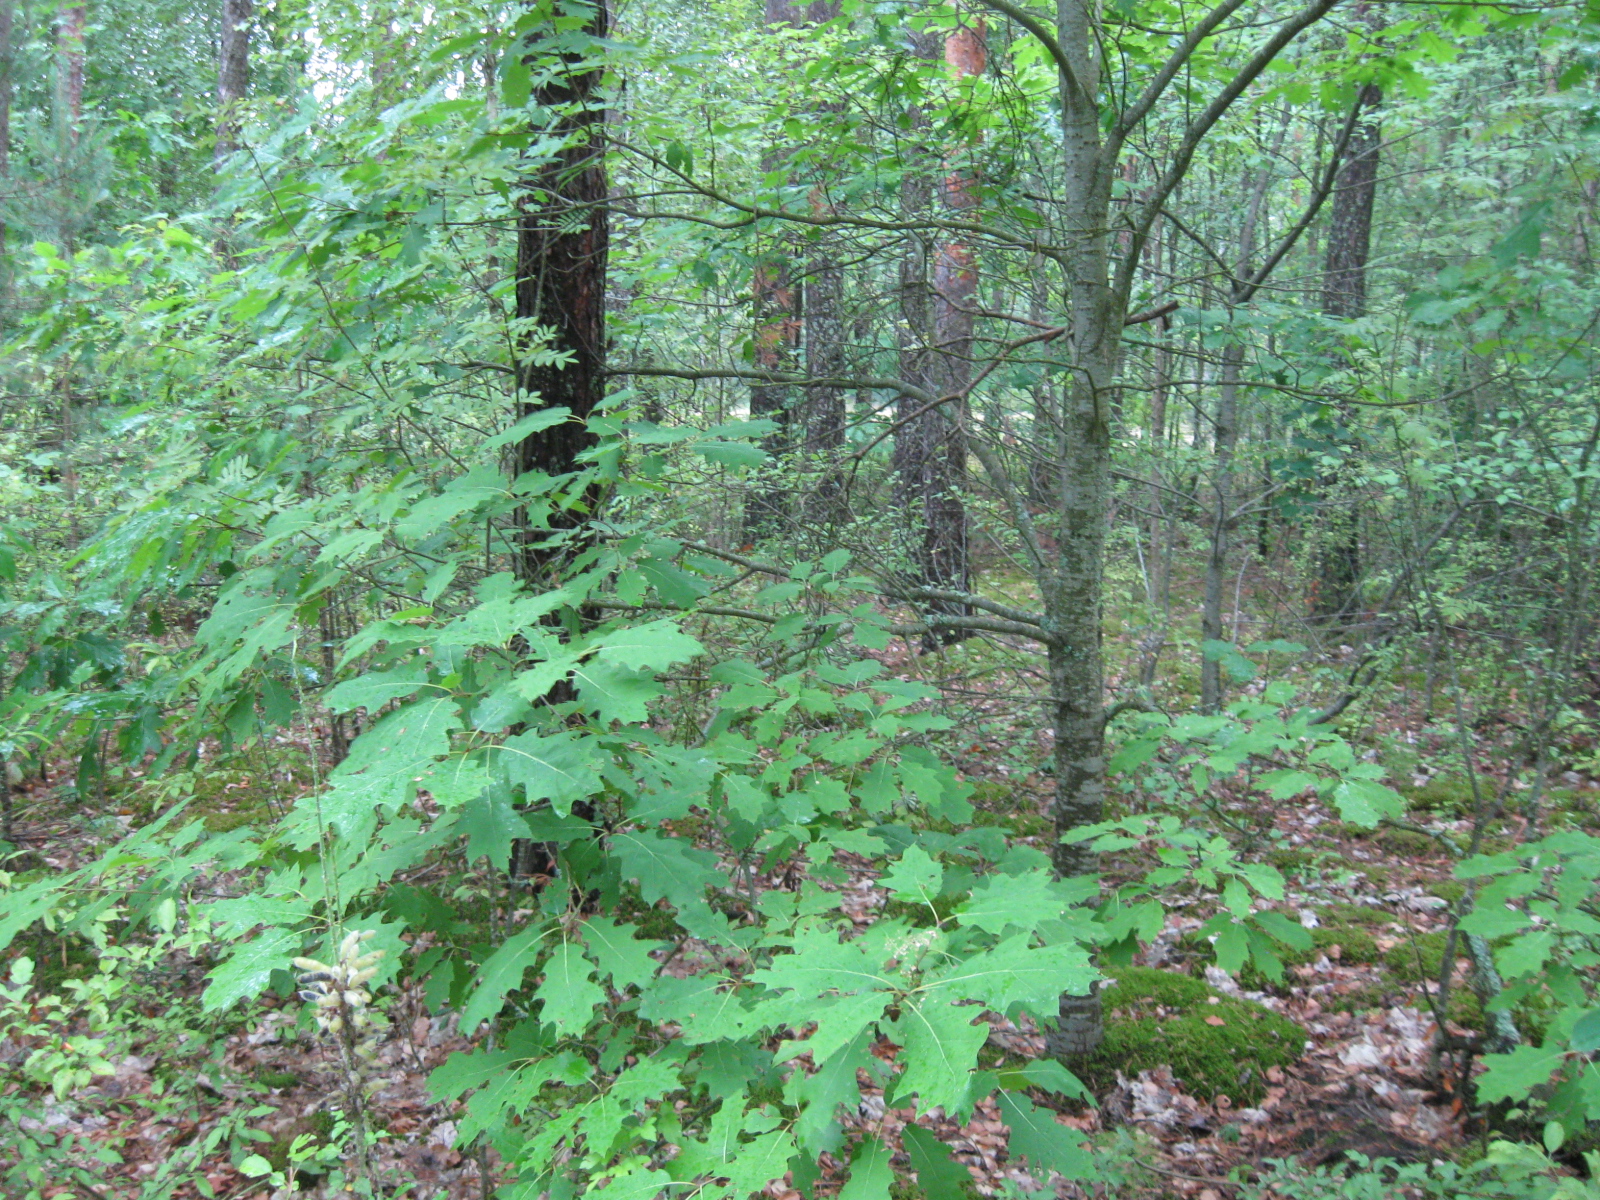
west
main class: Woodland
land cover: Pine dominated mixed woodland
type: hemiboreal forest and nemoral coniferous forest and mixed broadleaved-coniferous forest
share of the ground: > 75 %
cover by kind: coniferous forest trees 50 %, broadleaved forest trees 30 %, herbaceous plants 10 %, shrubs 5 %, lichens and mosses 5 %
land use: Forestry
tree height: > 5 m
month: July
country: LT
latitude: 53.9934
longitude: 23.6459
